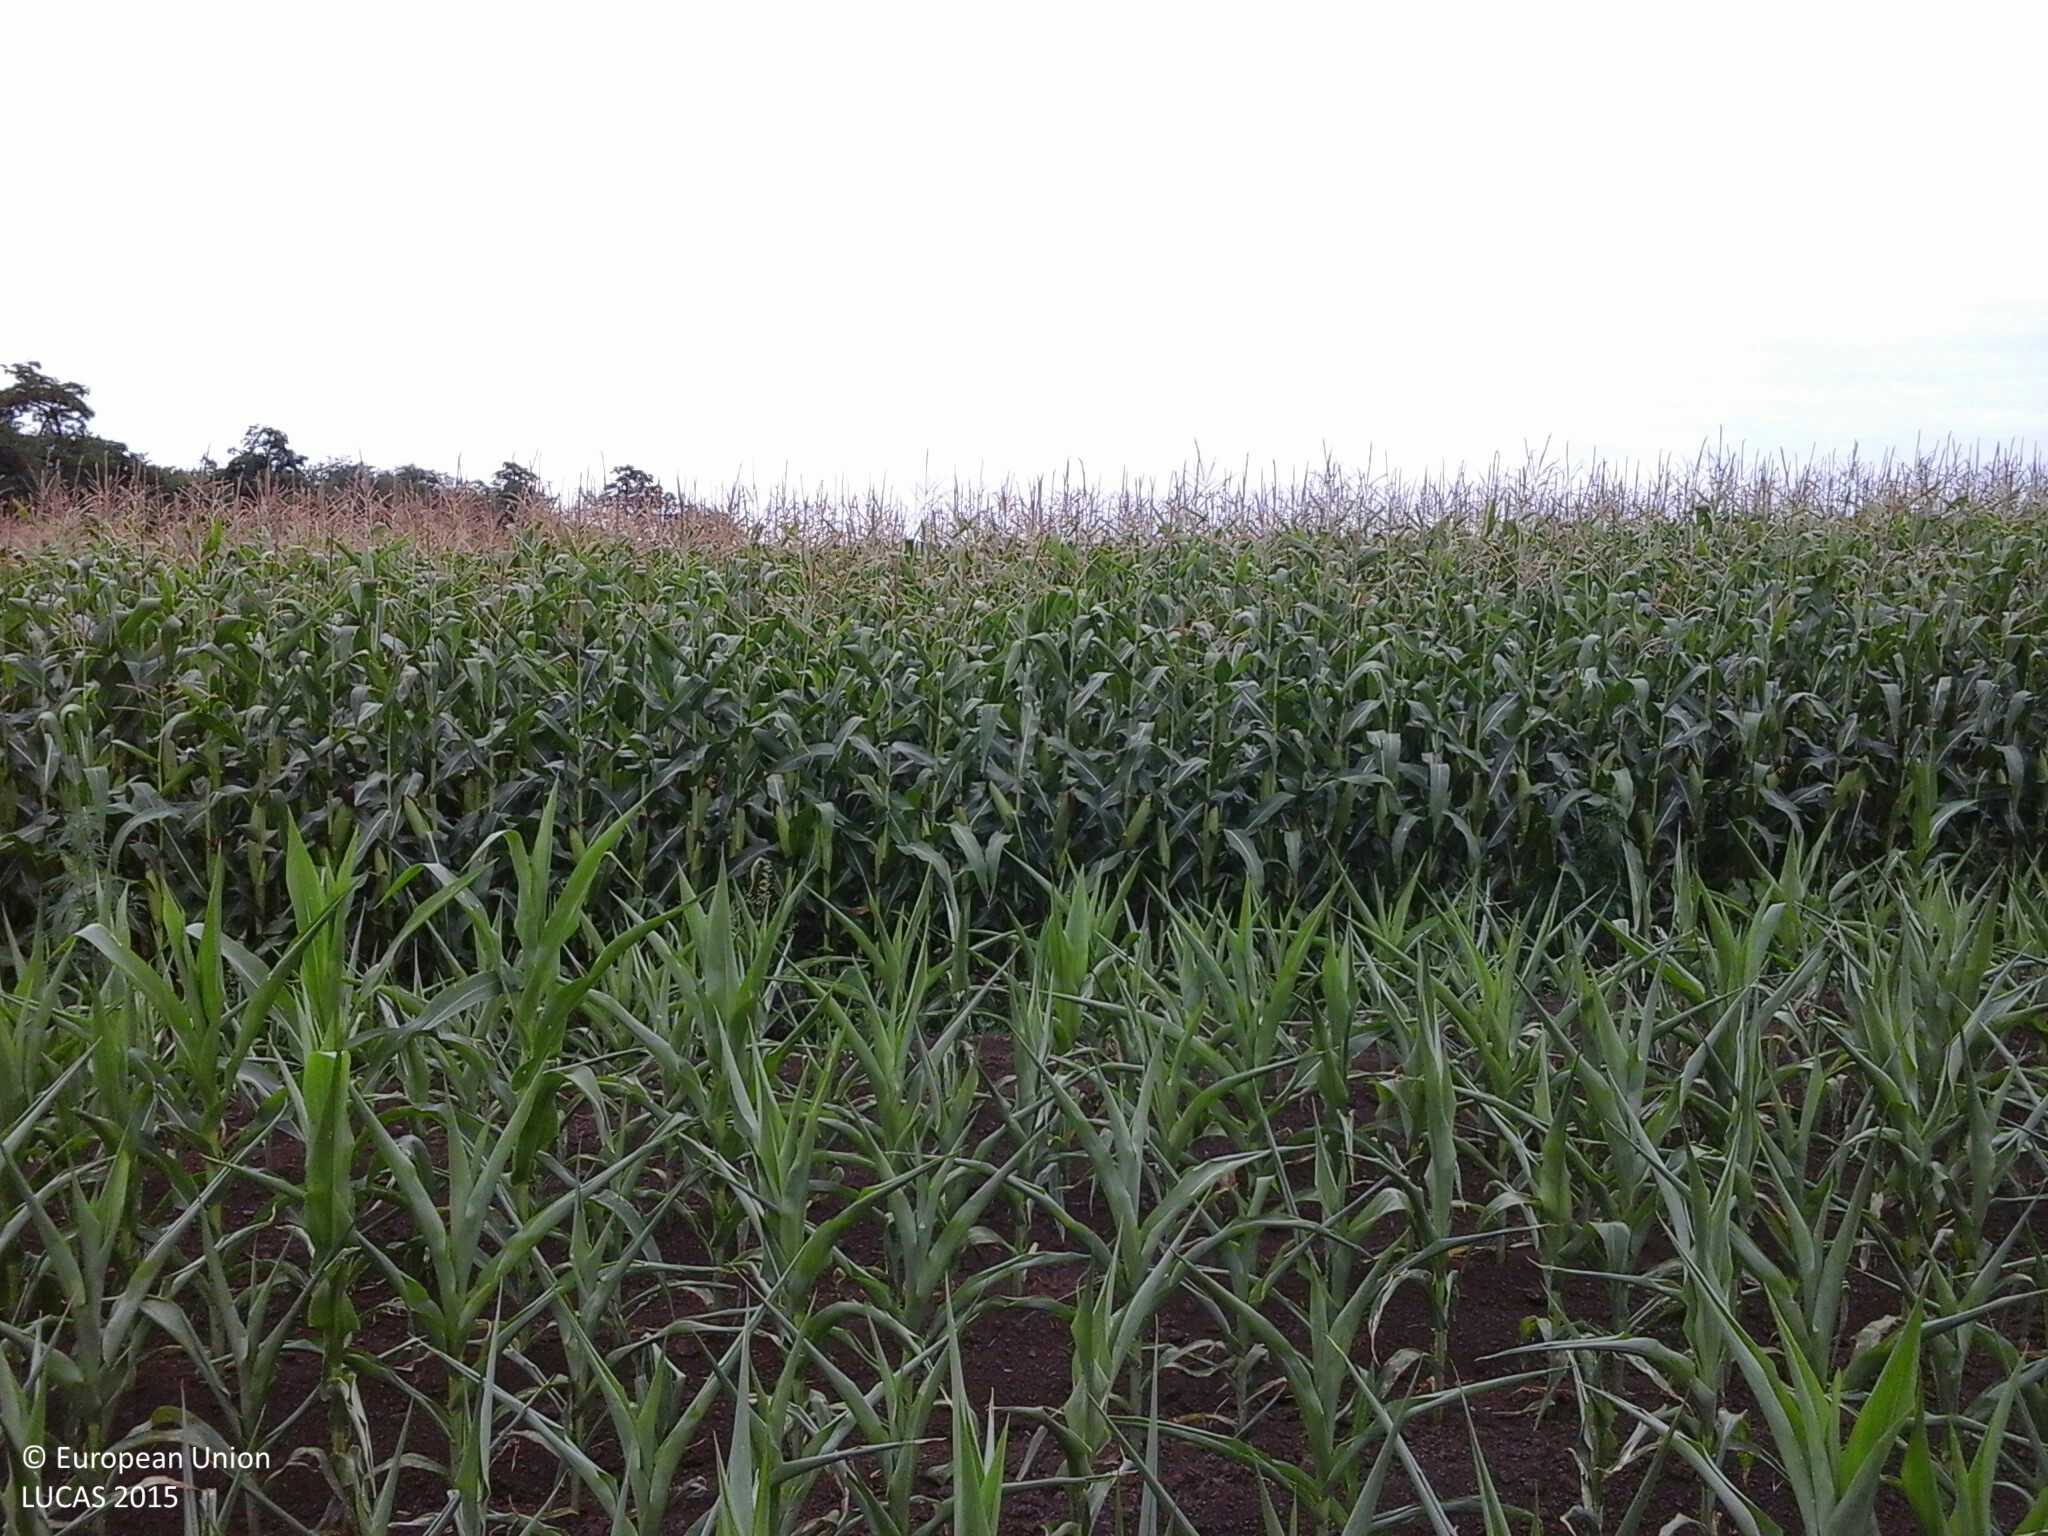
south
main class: Cropland
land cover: Maize
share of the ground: > 75 %
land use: Agriculture (excluding fallow land and kitchen gardens)
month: July
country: HU
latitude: 47.8736
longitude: 21.5027
